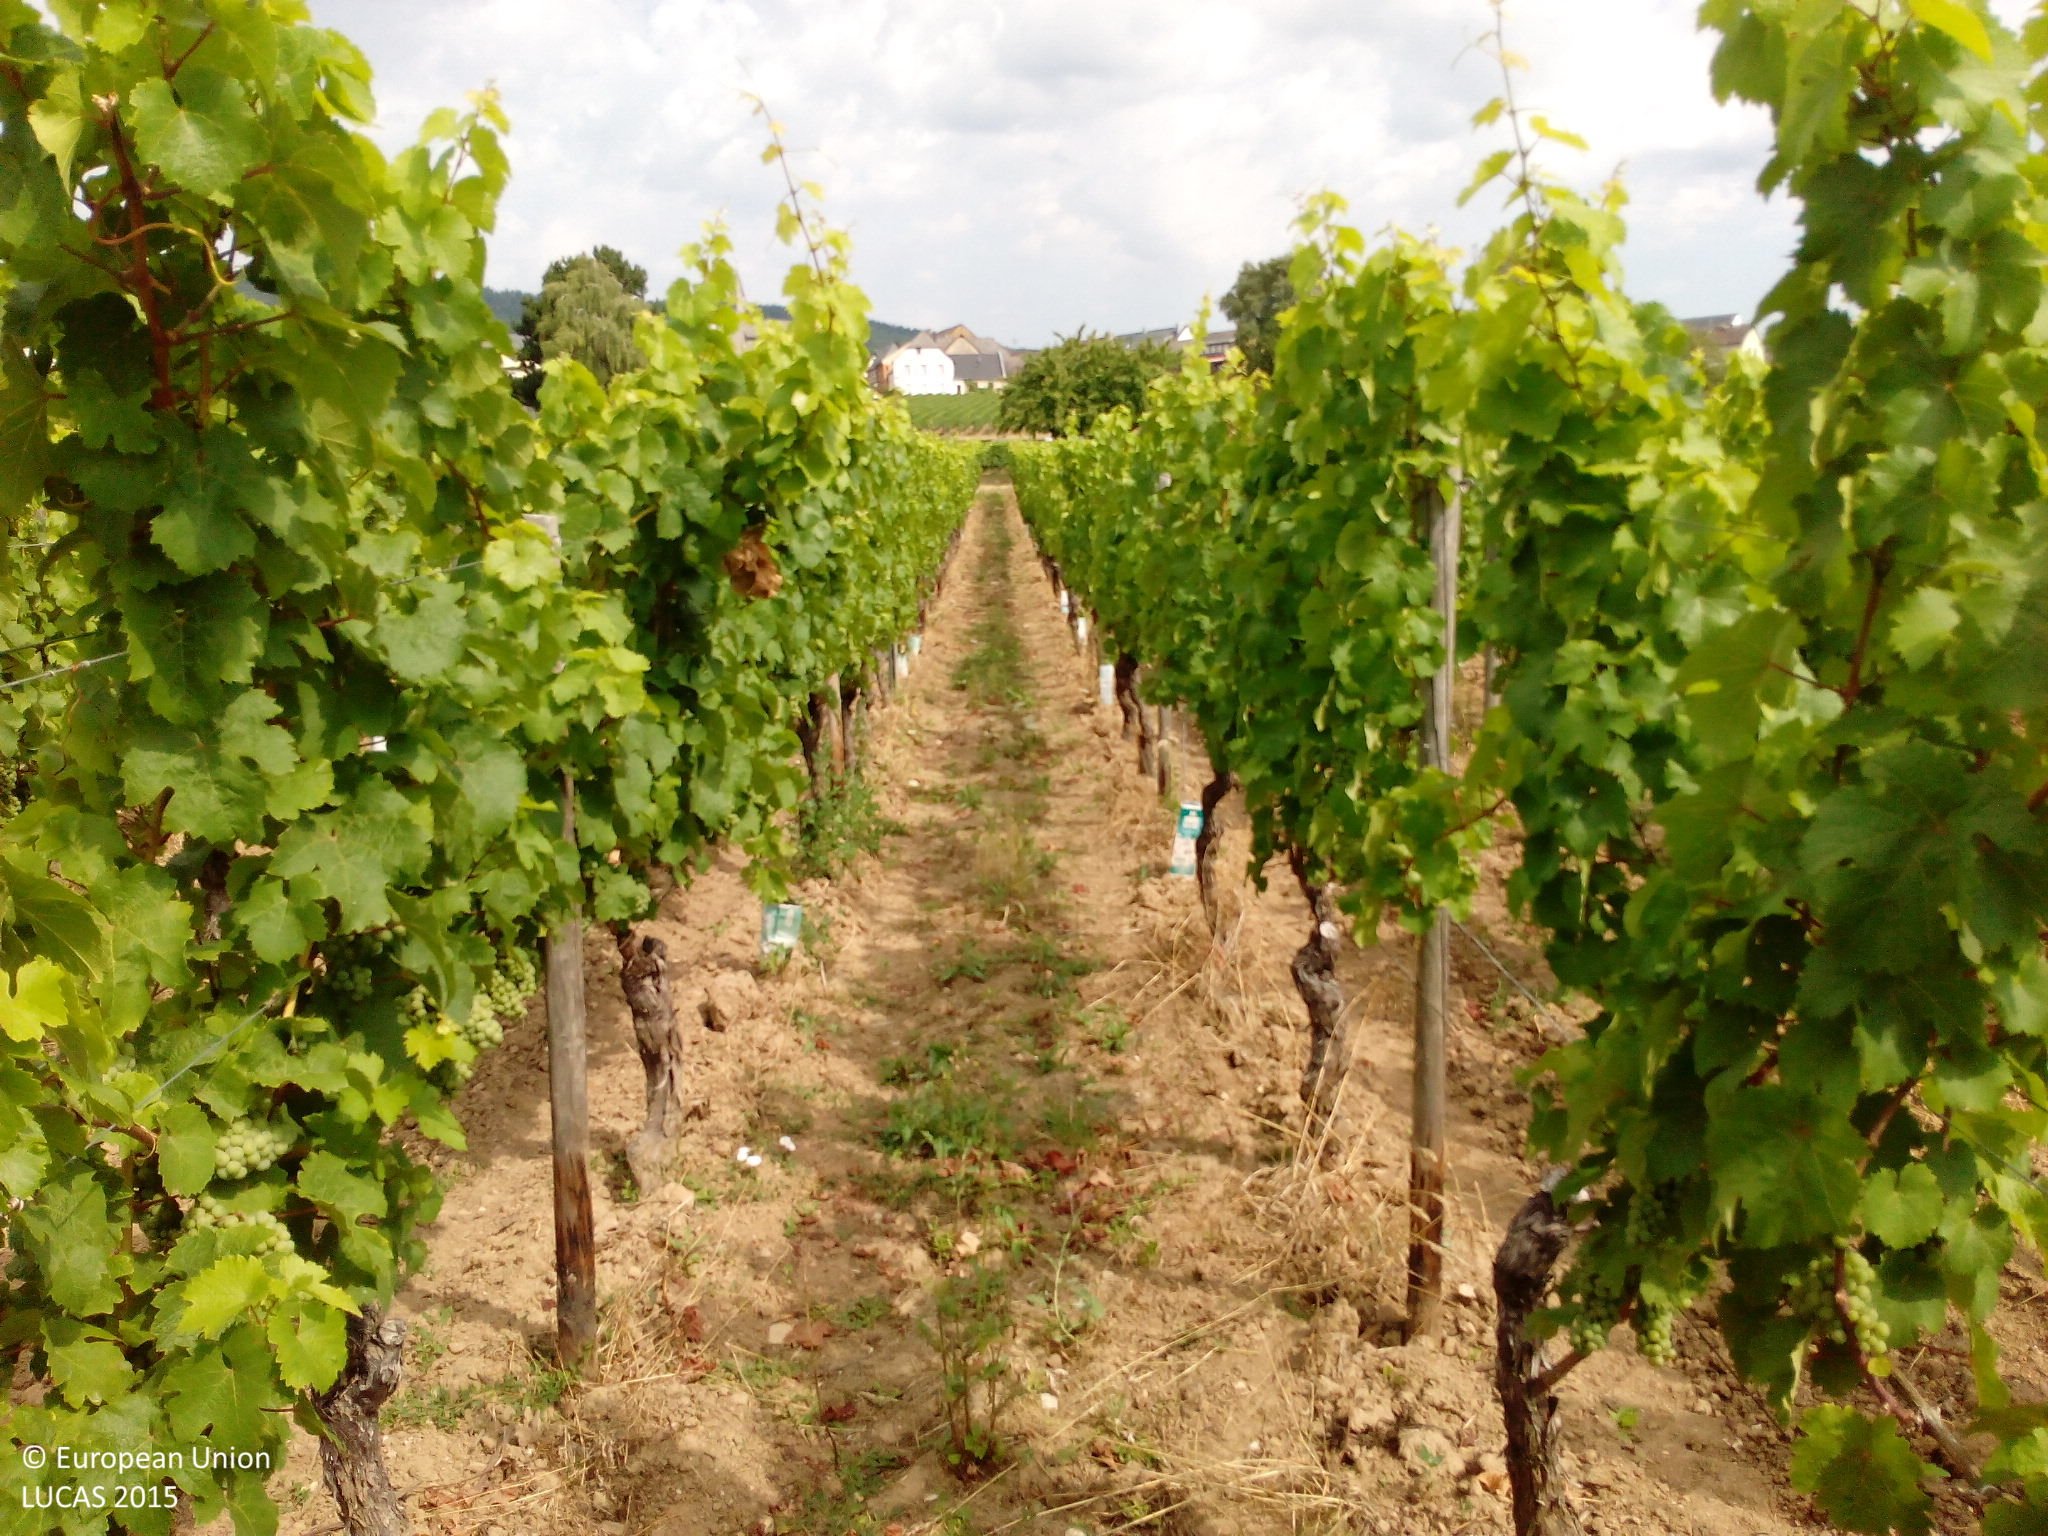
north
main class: Cropland
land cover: Vineyards
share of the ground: 25 - 50 %
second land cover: Spontaneously vegetated surfaces
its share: 10 - 25 %
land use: Agriculture (excluding fallow land and kitchen gardens)
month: August
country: DE
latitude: 50.0234
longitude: 8.0323
